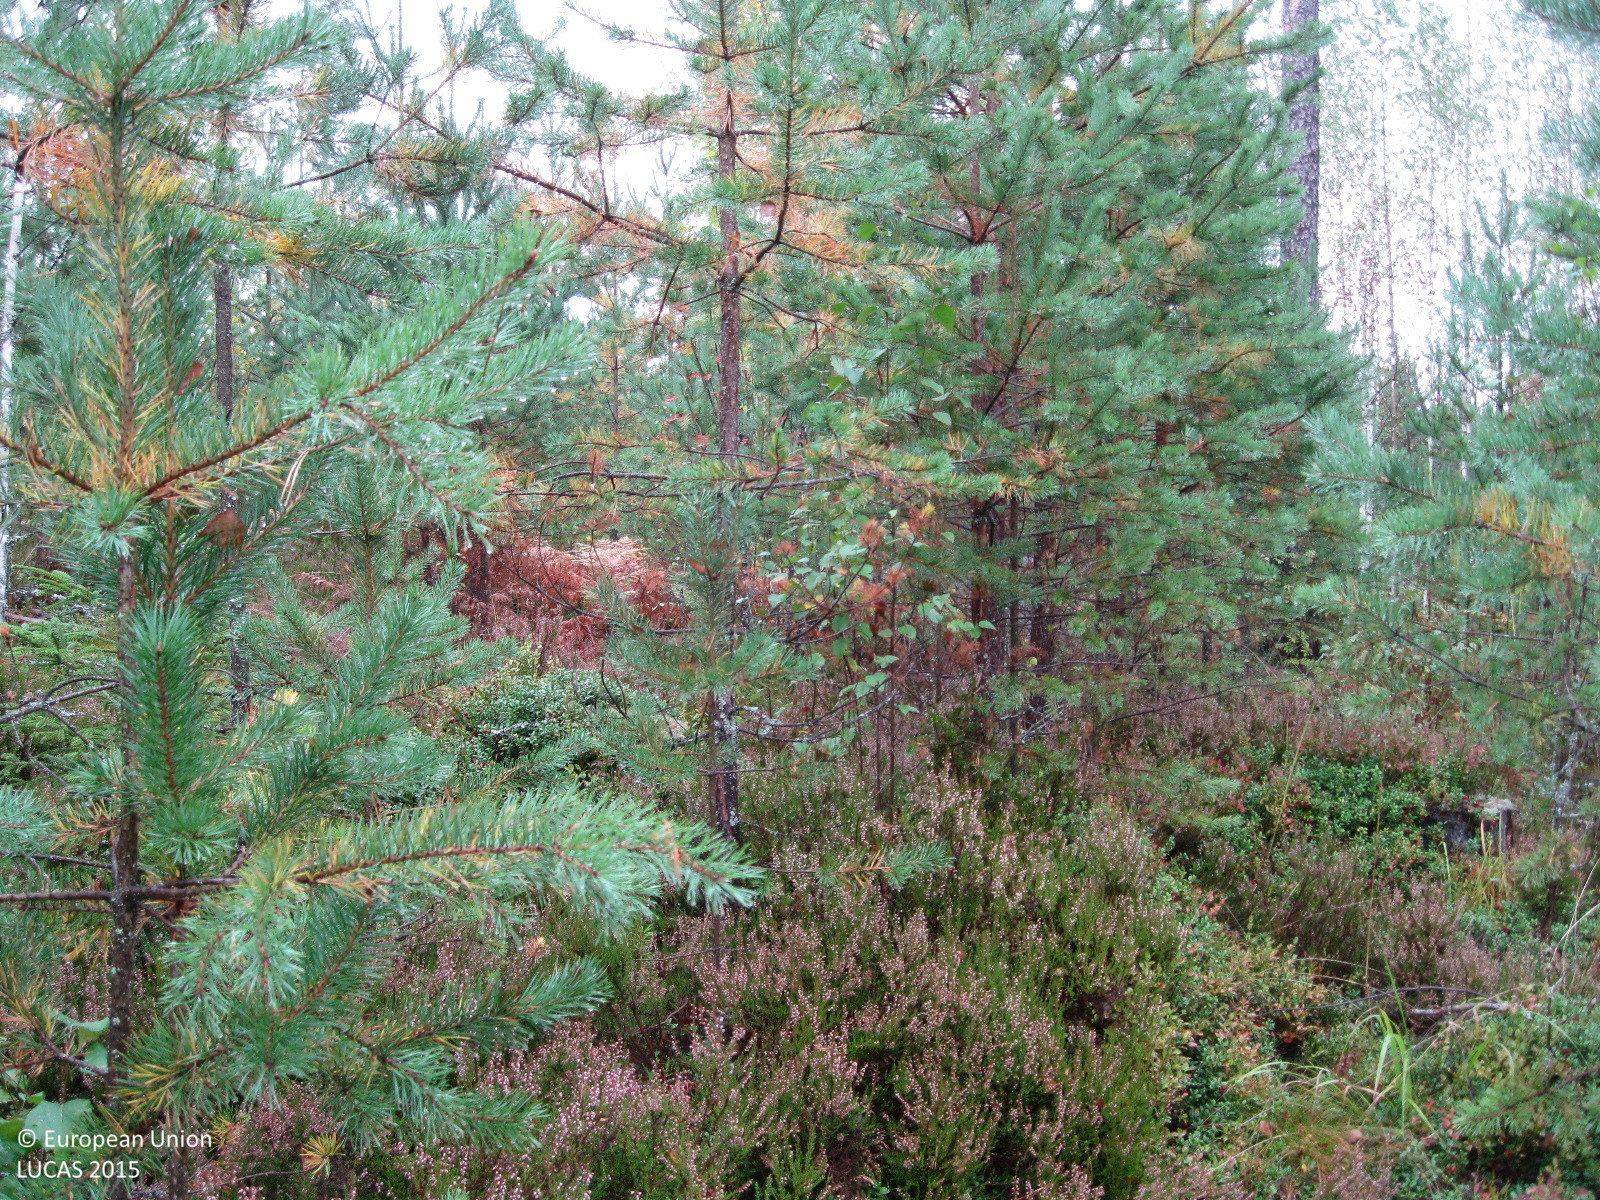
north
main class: Woodland
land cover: Pine dominated mixed woodland
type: boreal forest
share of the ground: 50 - 75 %
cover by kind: coniferous forest trees 50 %, shrubs 30 %, broadleaved forest trees 20 %
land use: Forestry
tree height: > 5 m
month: September
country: FI
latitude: 60.8774
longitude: 25.0166
